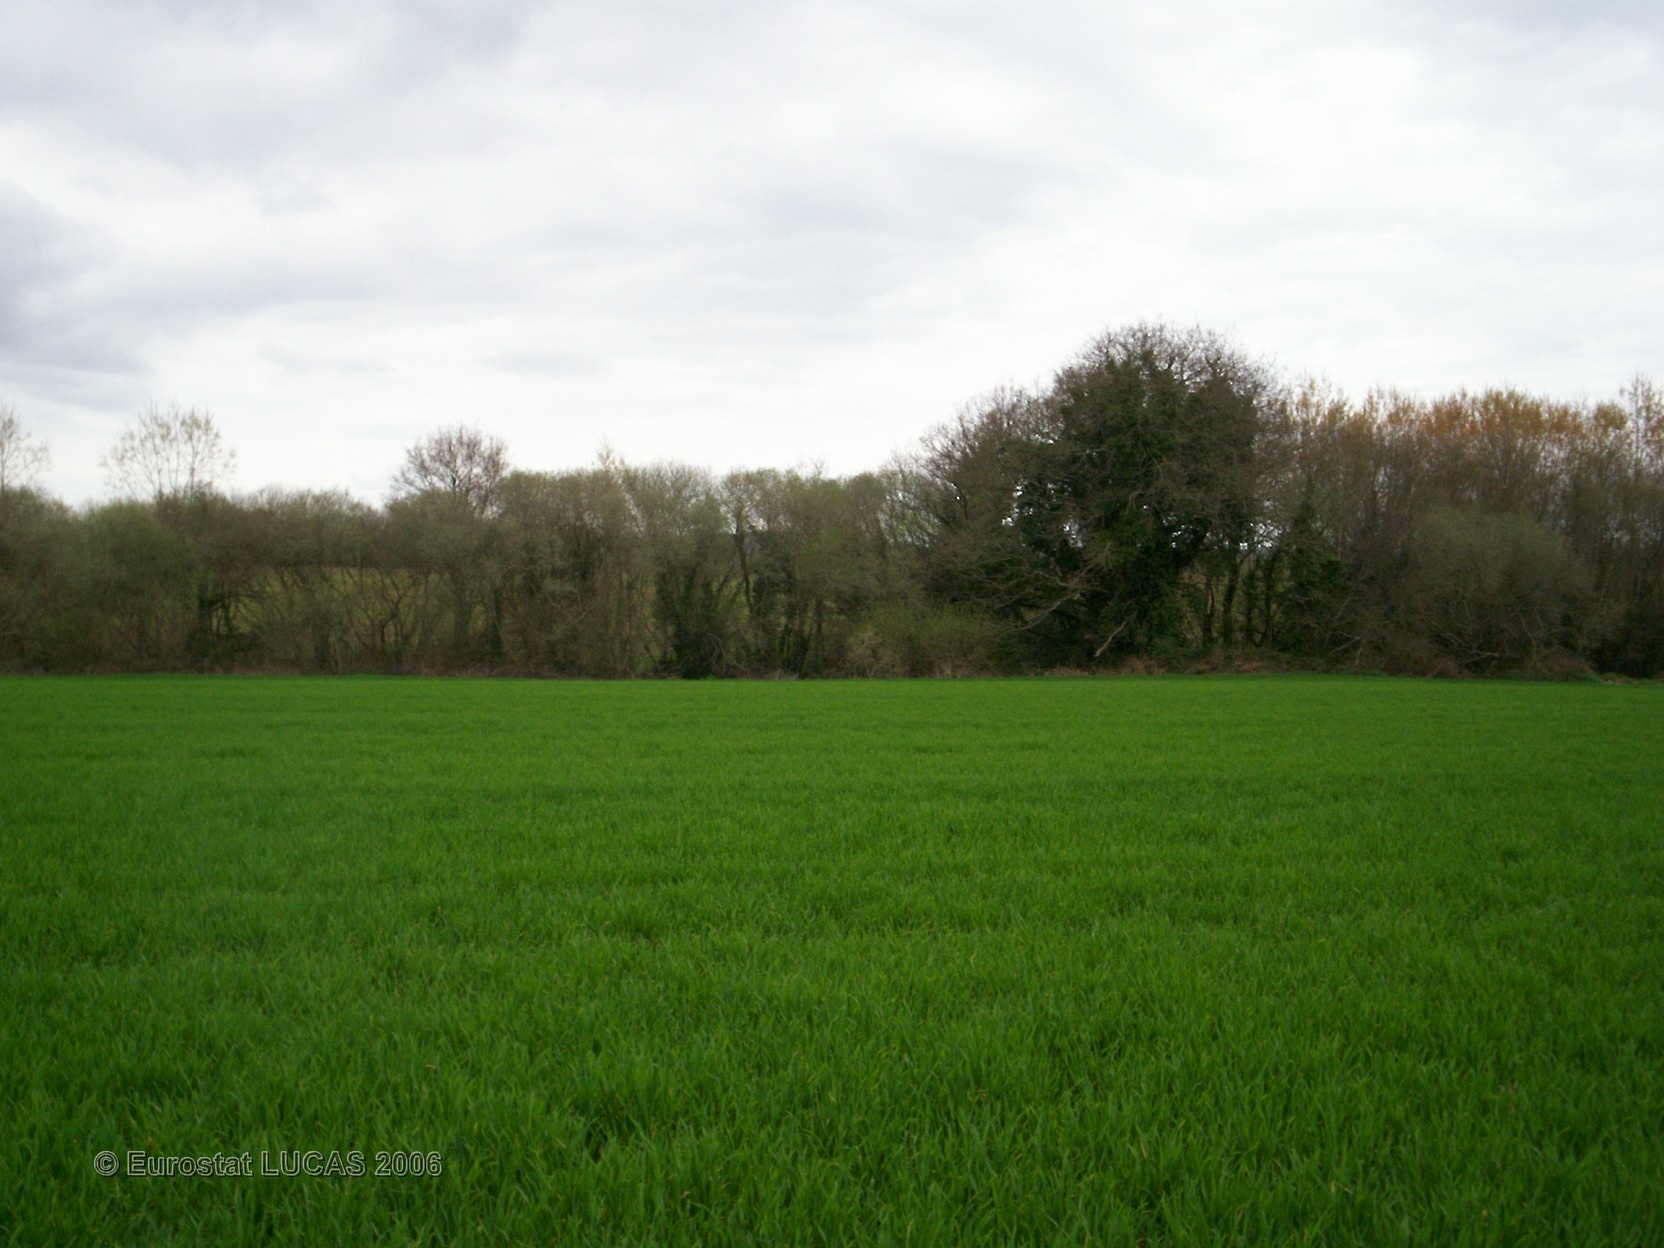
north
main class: Cropland
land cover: Common wheat
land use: Agriculture (excluding fallow land and kitchen gardens)
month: April
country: FR
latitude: 47.8295
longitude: -3.4740
